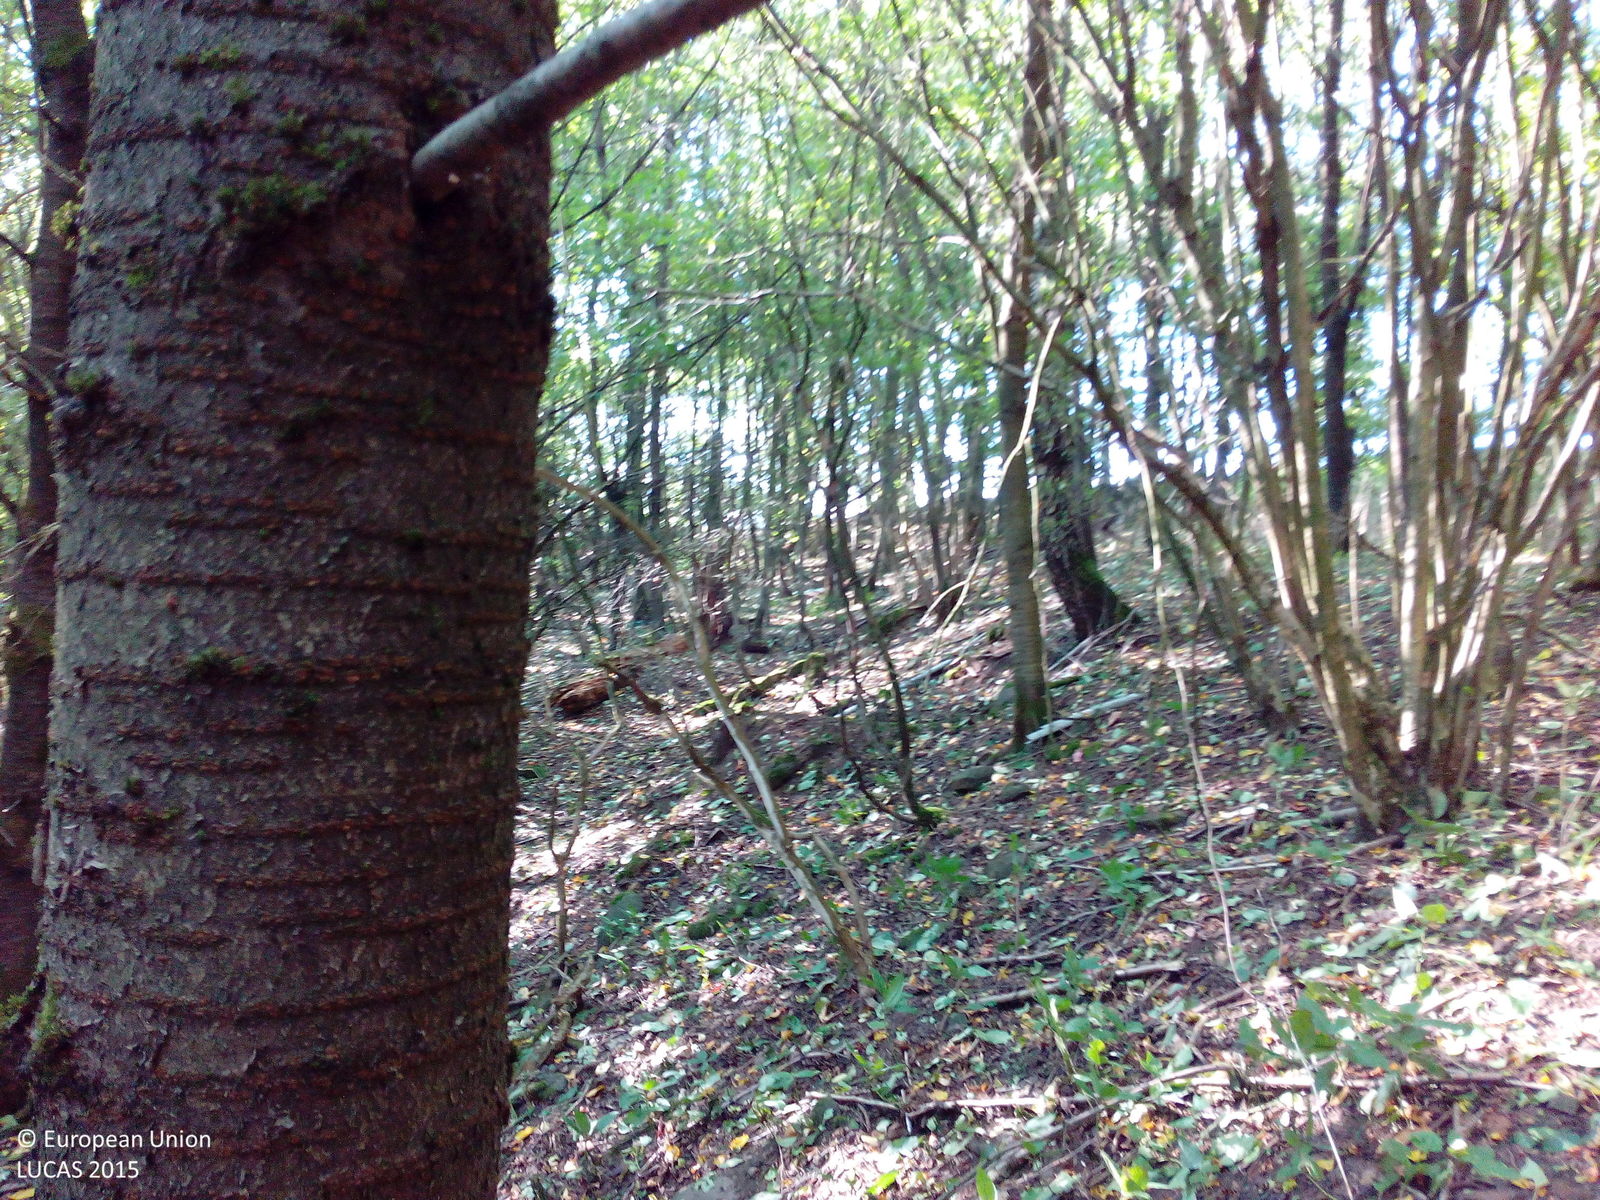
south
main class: Woodland
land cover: Broadleaved woodland
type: mesophytic deciduous forest
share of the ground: > 75 %
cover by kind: broadleaved forest trees 80 %, herbaceous plants 10 %, unconsolidated bare surface 10 %
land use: Forestry
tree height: > 5 m
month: September
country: DE
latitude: 50.3431
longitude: 9.1712
